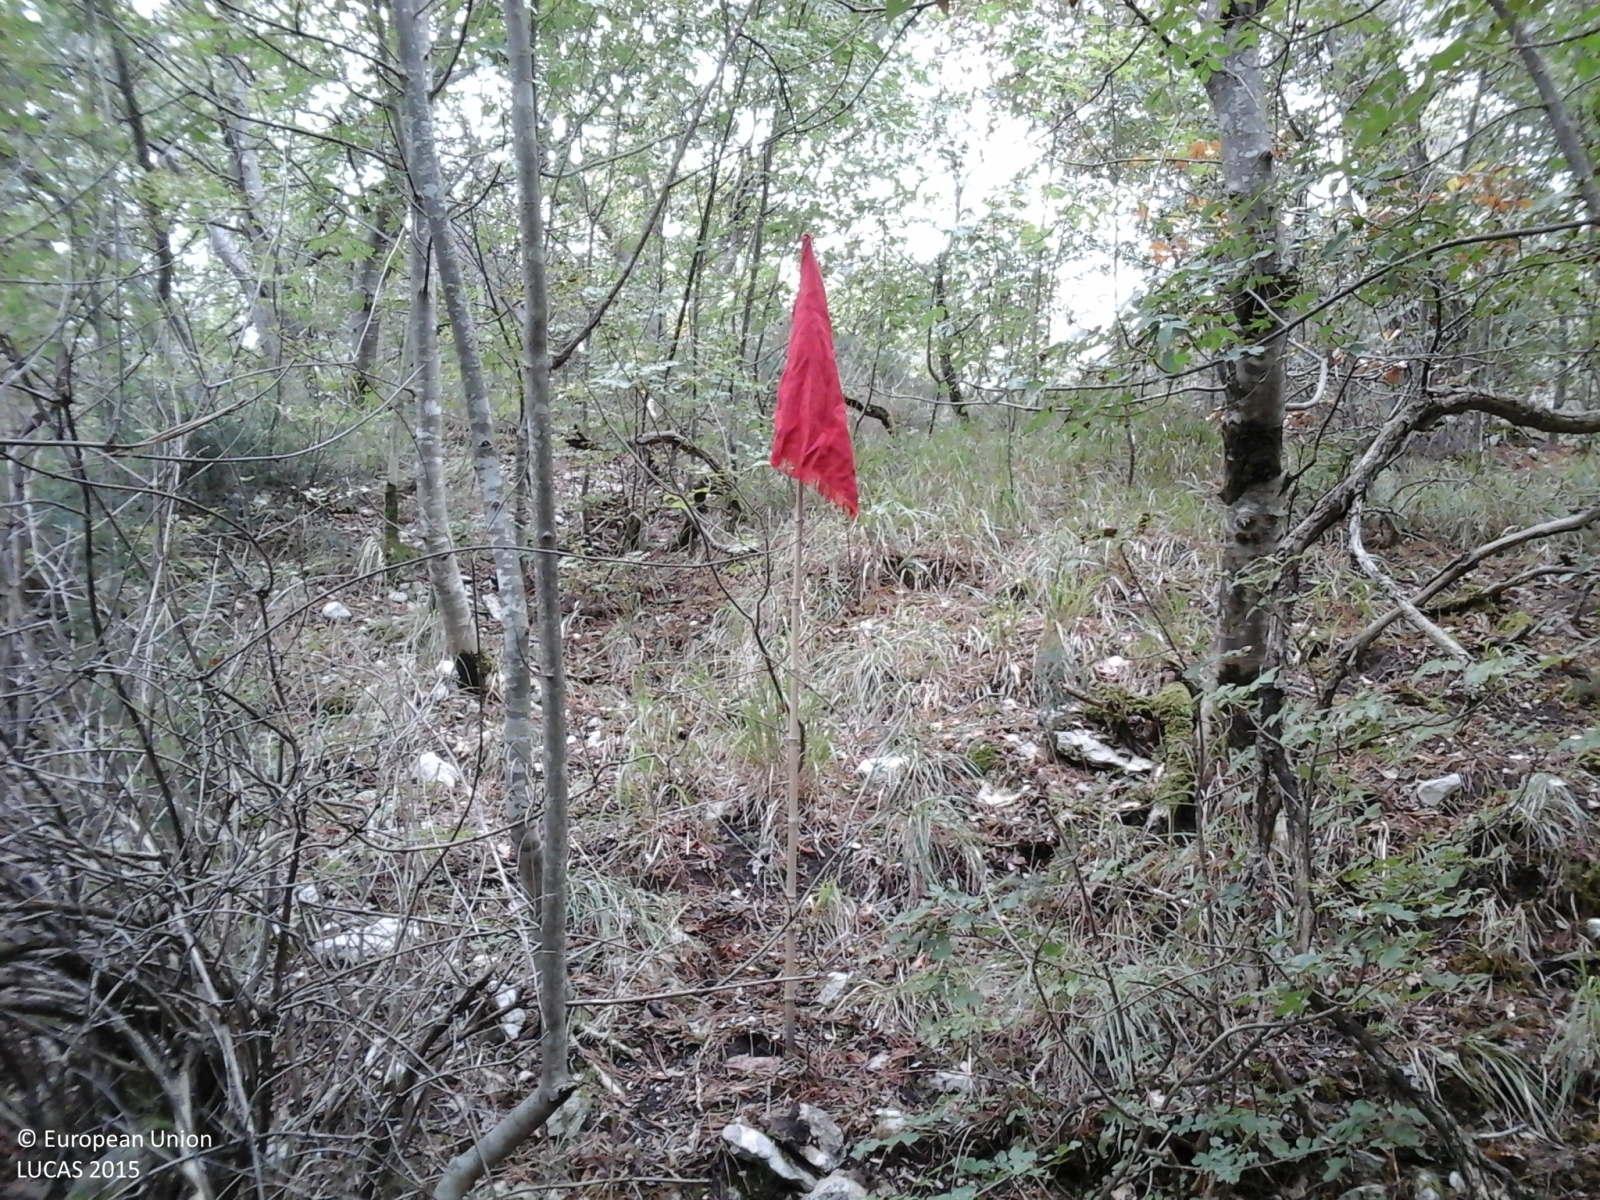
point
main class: Woodland
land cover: Broadleaved woodland
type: thermophilous deciduous forest
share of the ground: > 75 %
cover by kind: broadleaved forest trees 100 %
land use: Forestry
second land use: Other primary production
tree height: < 5 m
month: September
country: IT
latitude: 43.3736
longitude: 12.8188
